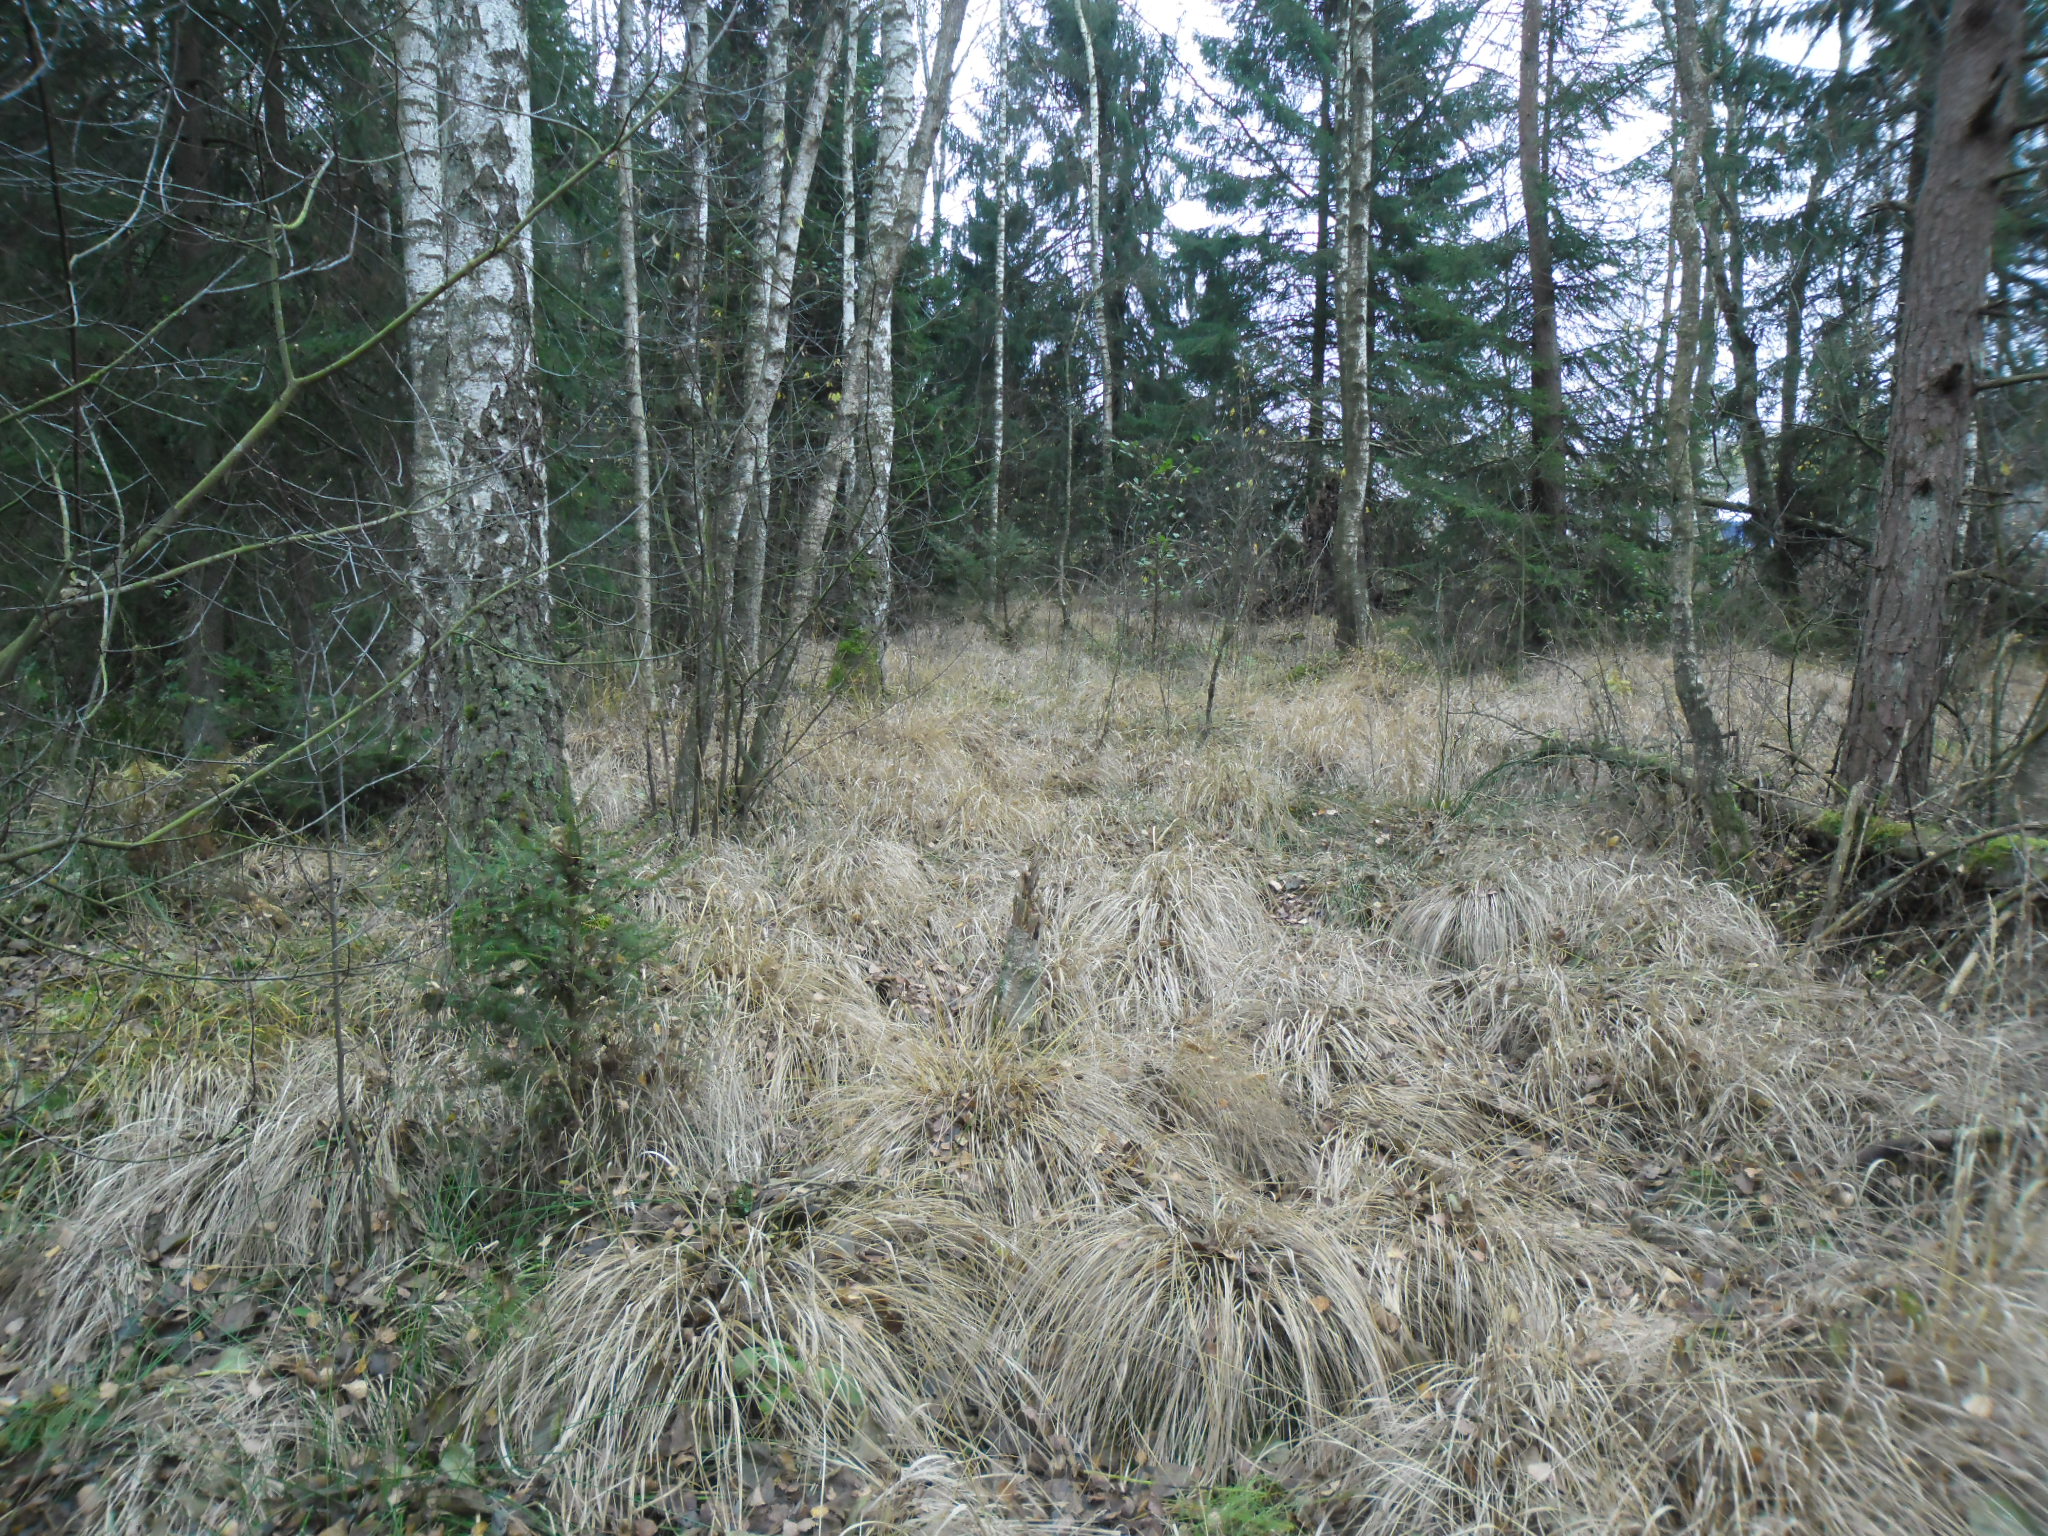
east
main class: Woodland
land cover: Other mixed woodland
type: boreal forest
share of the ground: > 75 %
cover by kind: broadleaved forest trees 60 %, coniferous forest trees 20 %, herbaceous plants 20 %
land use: Forestry
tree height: > 5 m
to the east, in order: Other mixed woodland; Fences; Grassland without tree/shrub cover; Tracks; Inland marshes; Grassland with sparse tree/shrub cover; Other mixed woodland
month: November
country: SE
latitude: 56.2939
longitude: 13.1157
